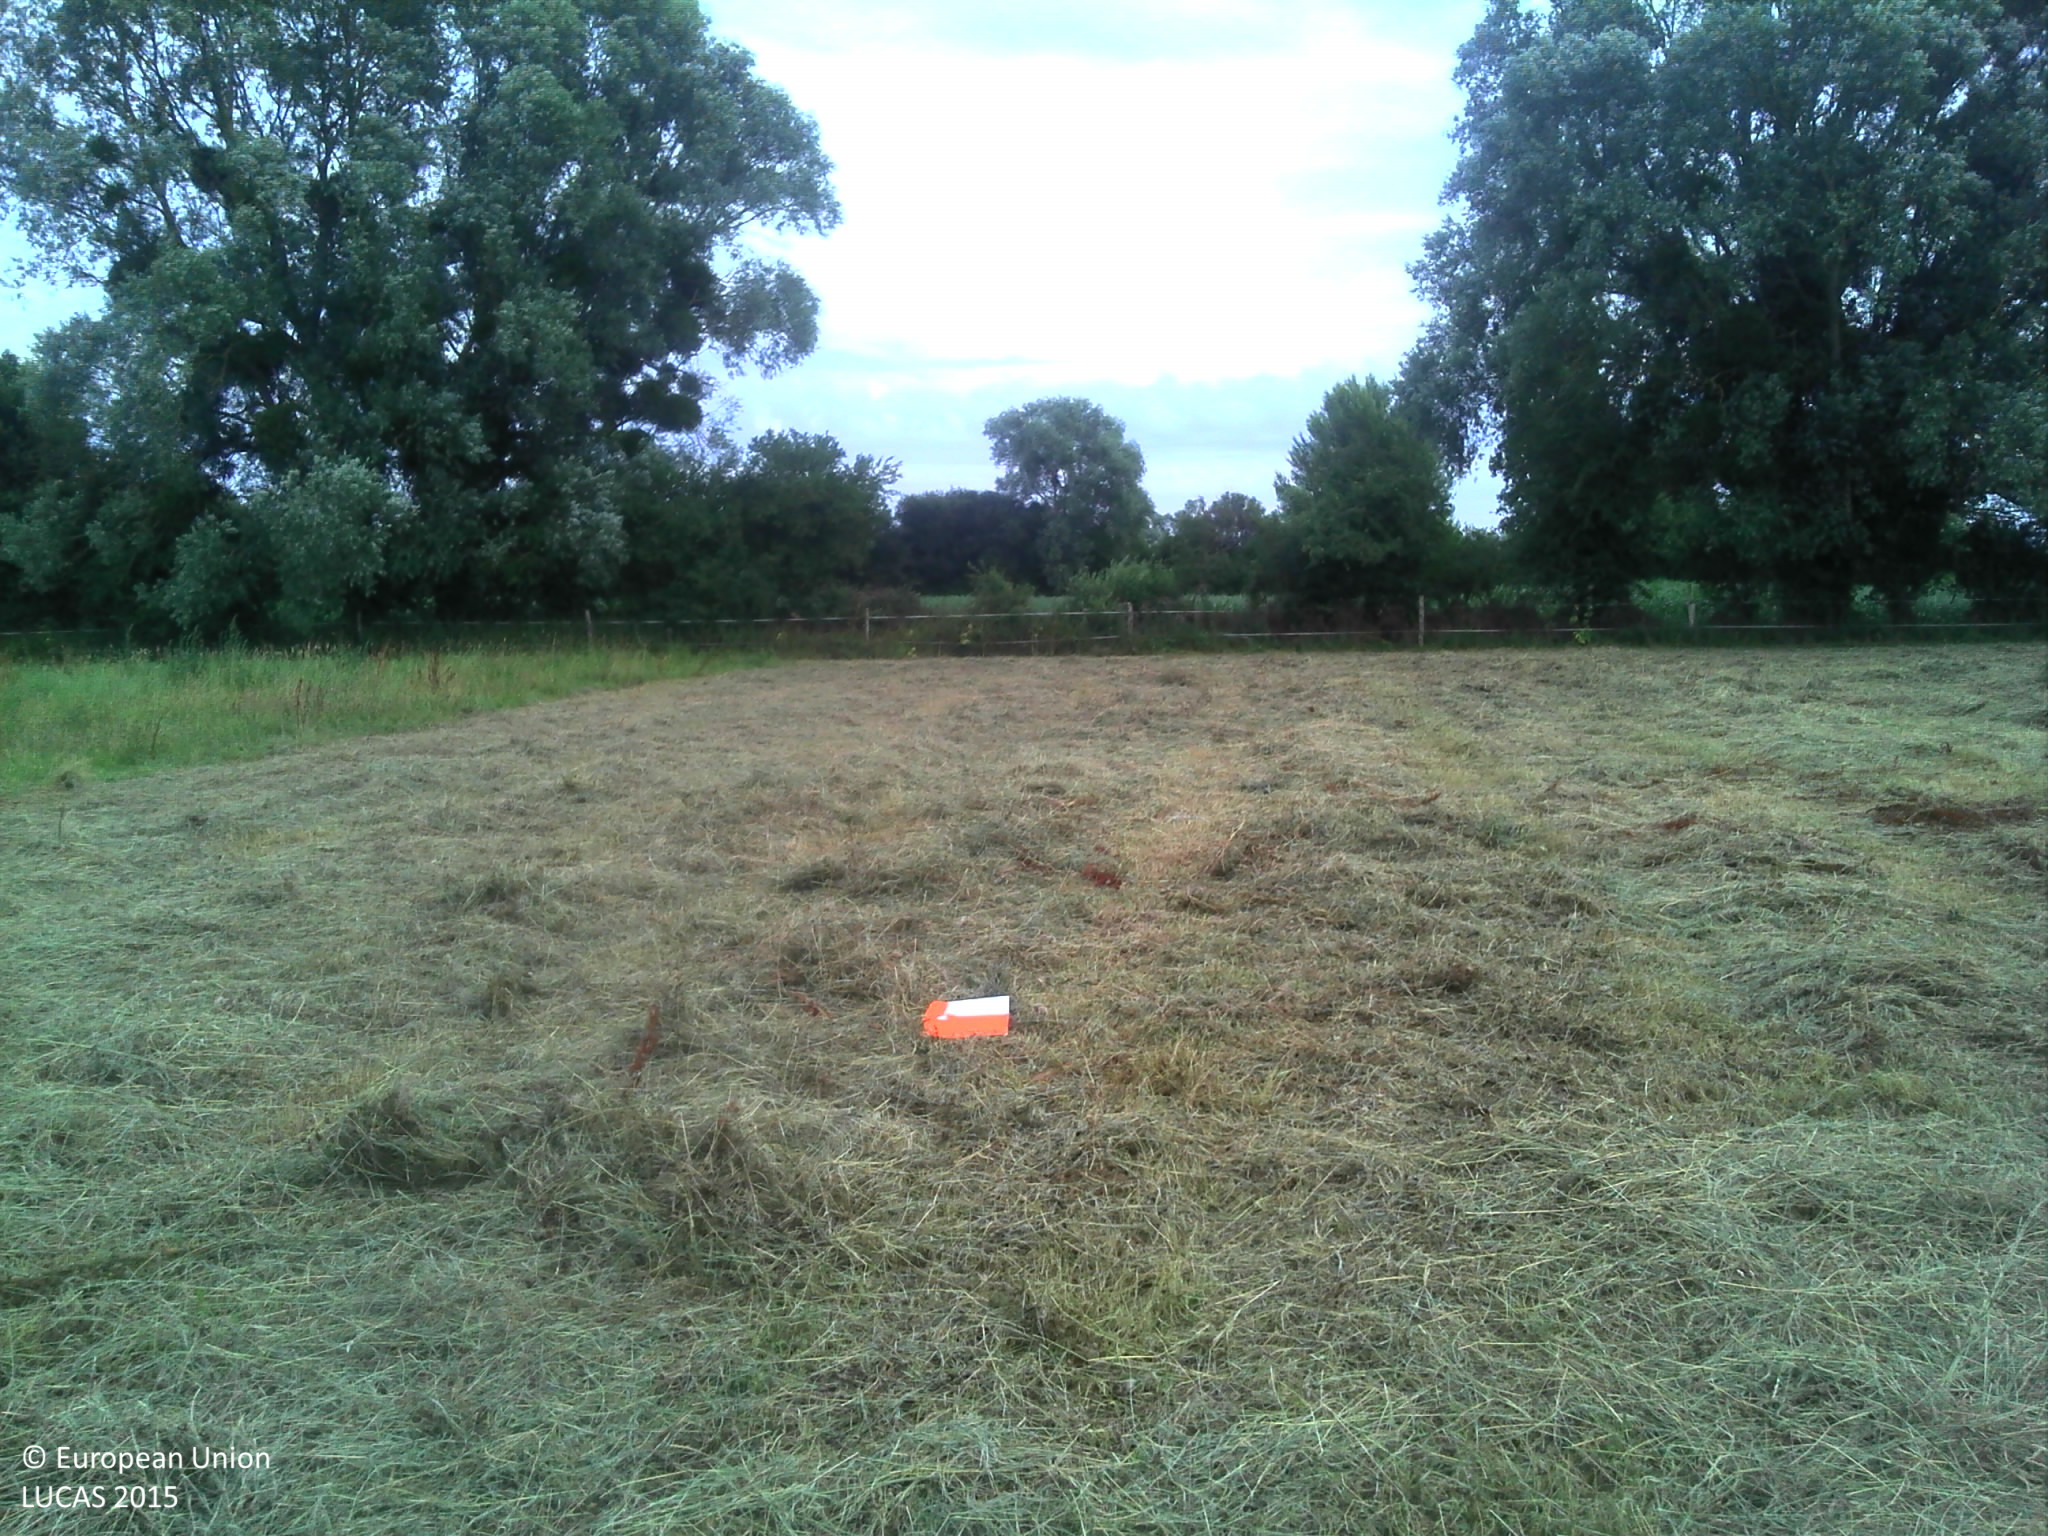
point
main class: Grassland
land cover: Grassland without tree/shrub cover
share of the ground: > 75 %
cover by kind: herbaceous plants 100 %
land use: Agriculture (excluding fallow land and kitchen gardens)
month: July
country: FR
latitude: 48.6917
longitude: -1.4998
